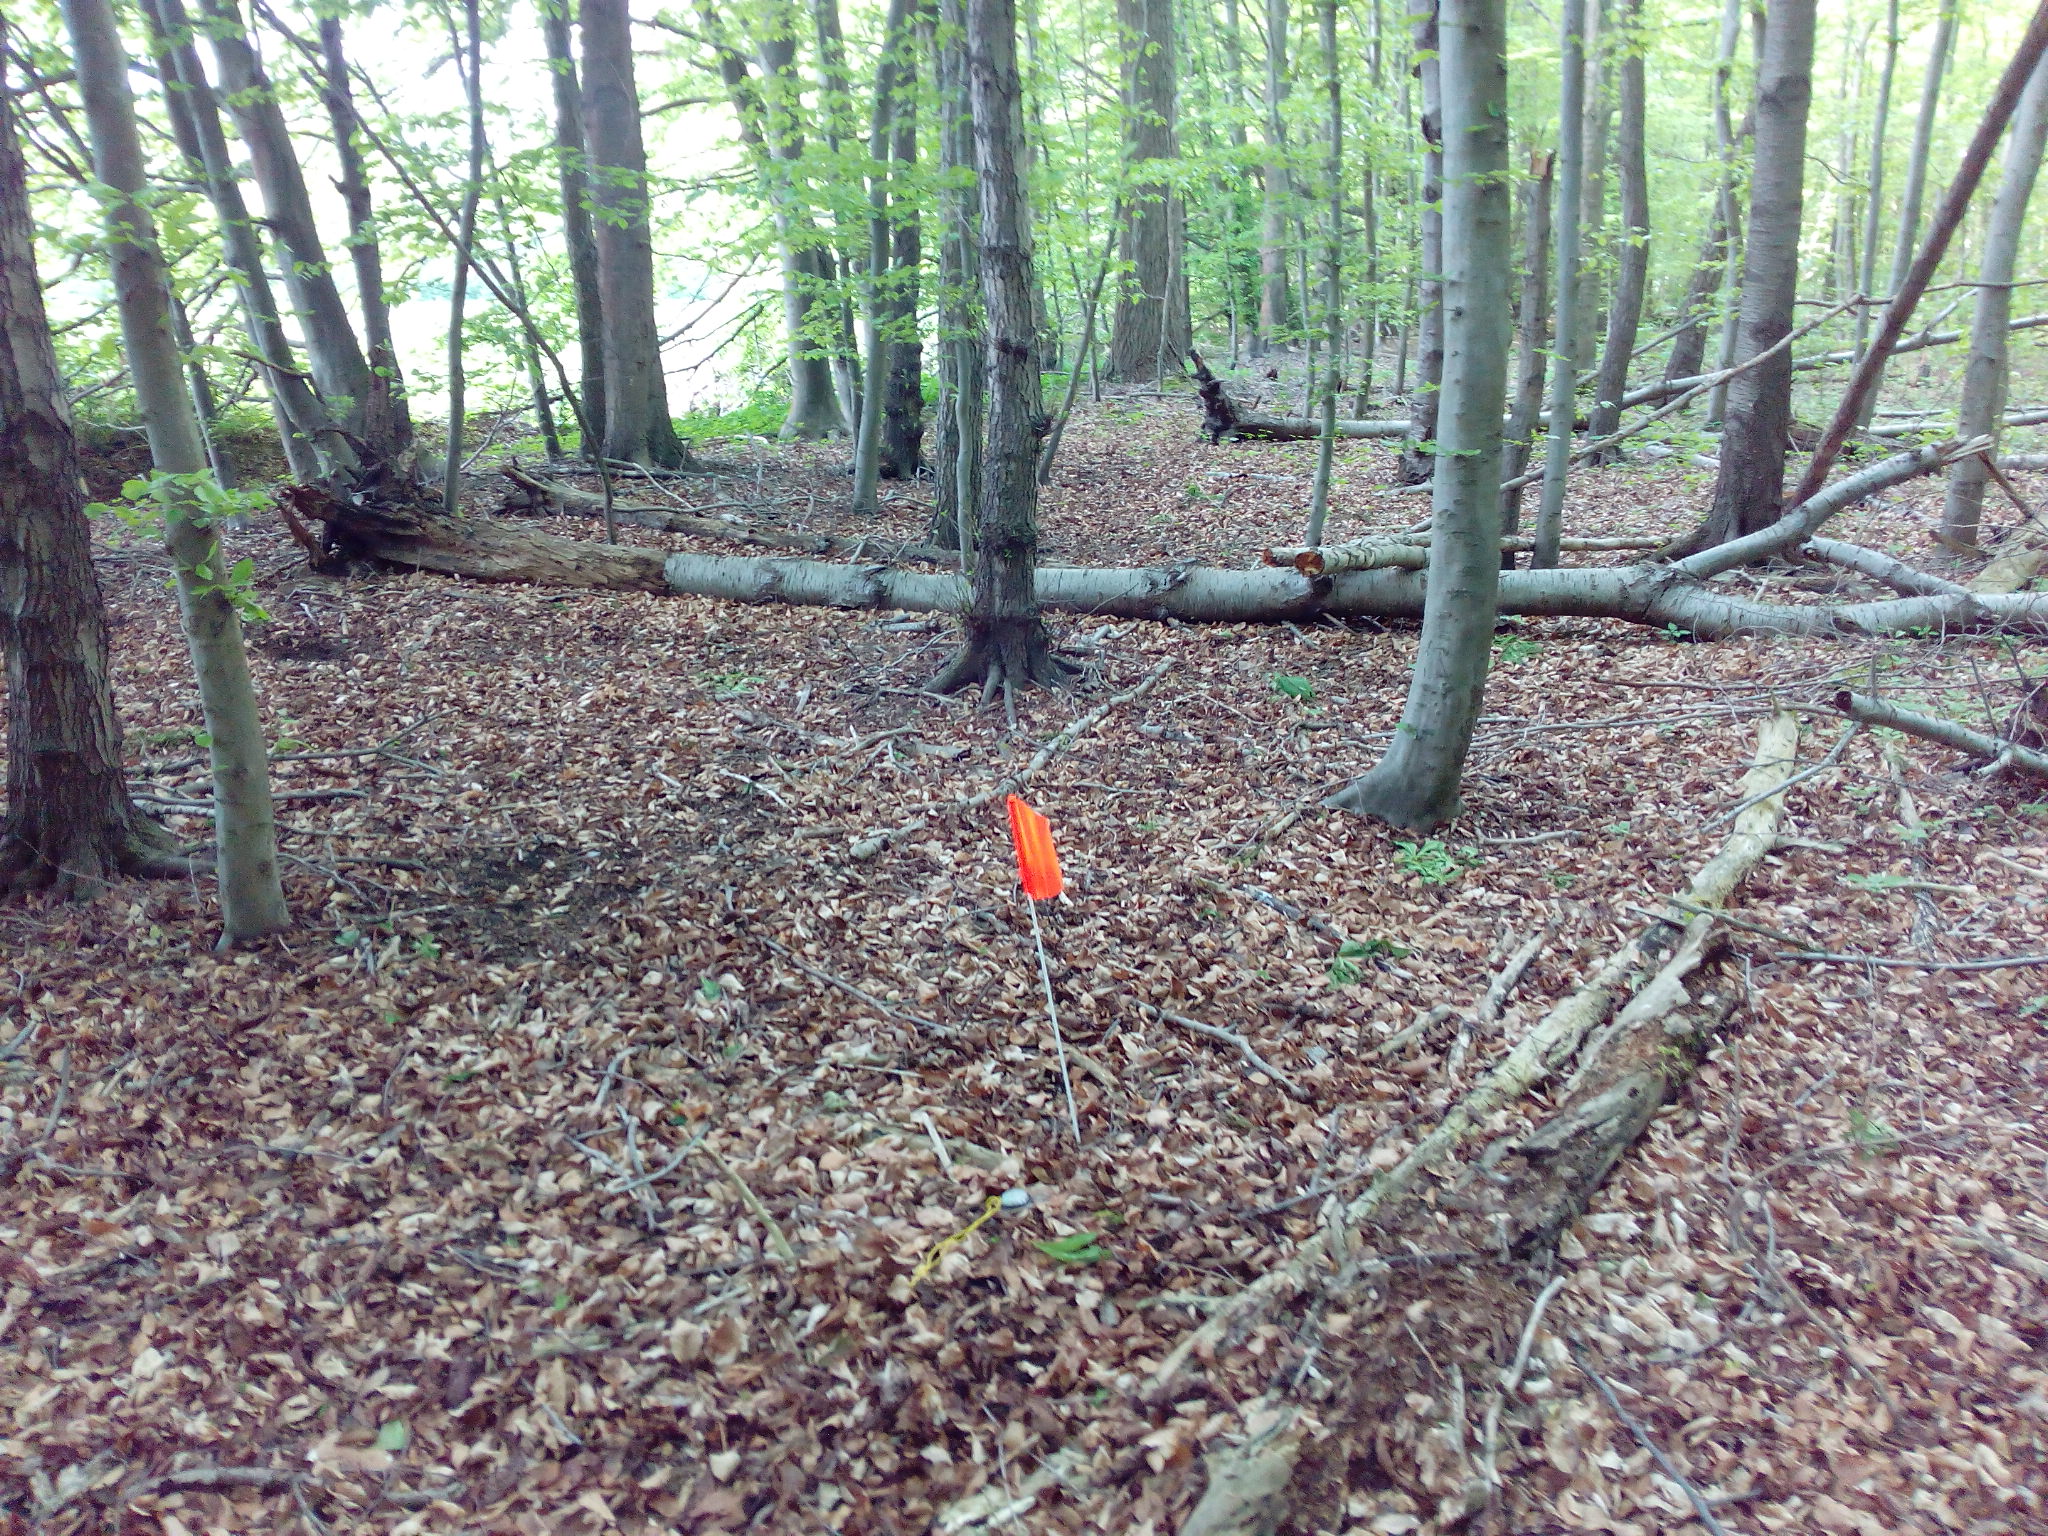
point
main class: Woodland
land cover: Broadleaved woodland
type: beech forest
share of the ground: > 75 %
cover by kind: broadleaved forest trees 95 %, herbaceous plants 5 %
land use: Forestry
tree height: > 5 m
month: May
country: DE
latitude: 52.3954
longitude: 9.8678
